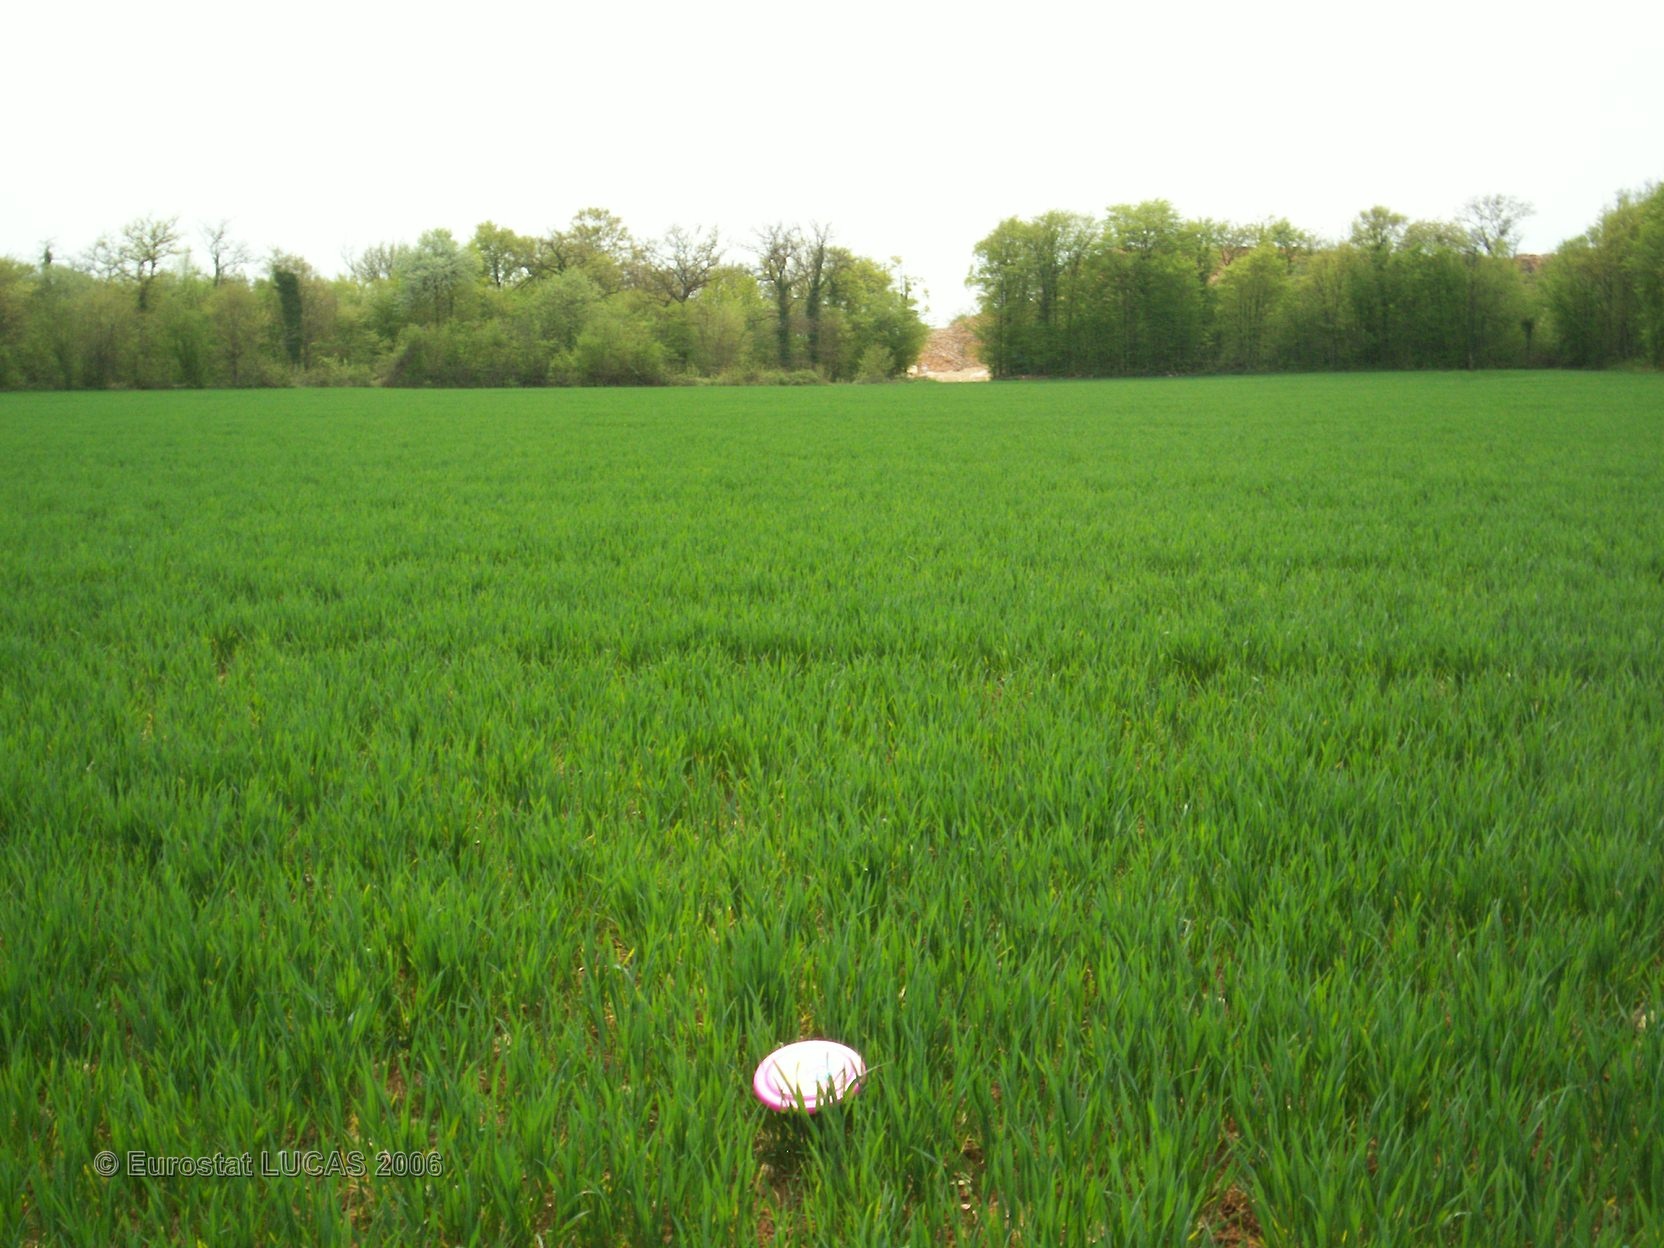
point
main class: Cropland
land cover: Common wheat
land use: Agriculture (excluding fallow land and kitchen gardens)
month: May
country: FR
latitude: 47.6932
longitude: 4.5760
